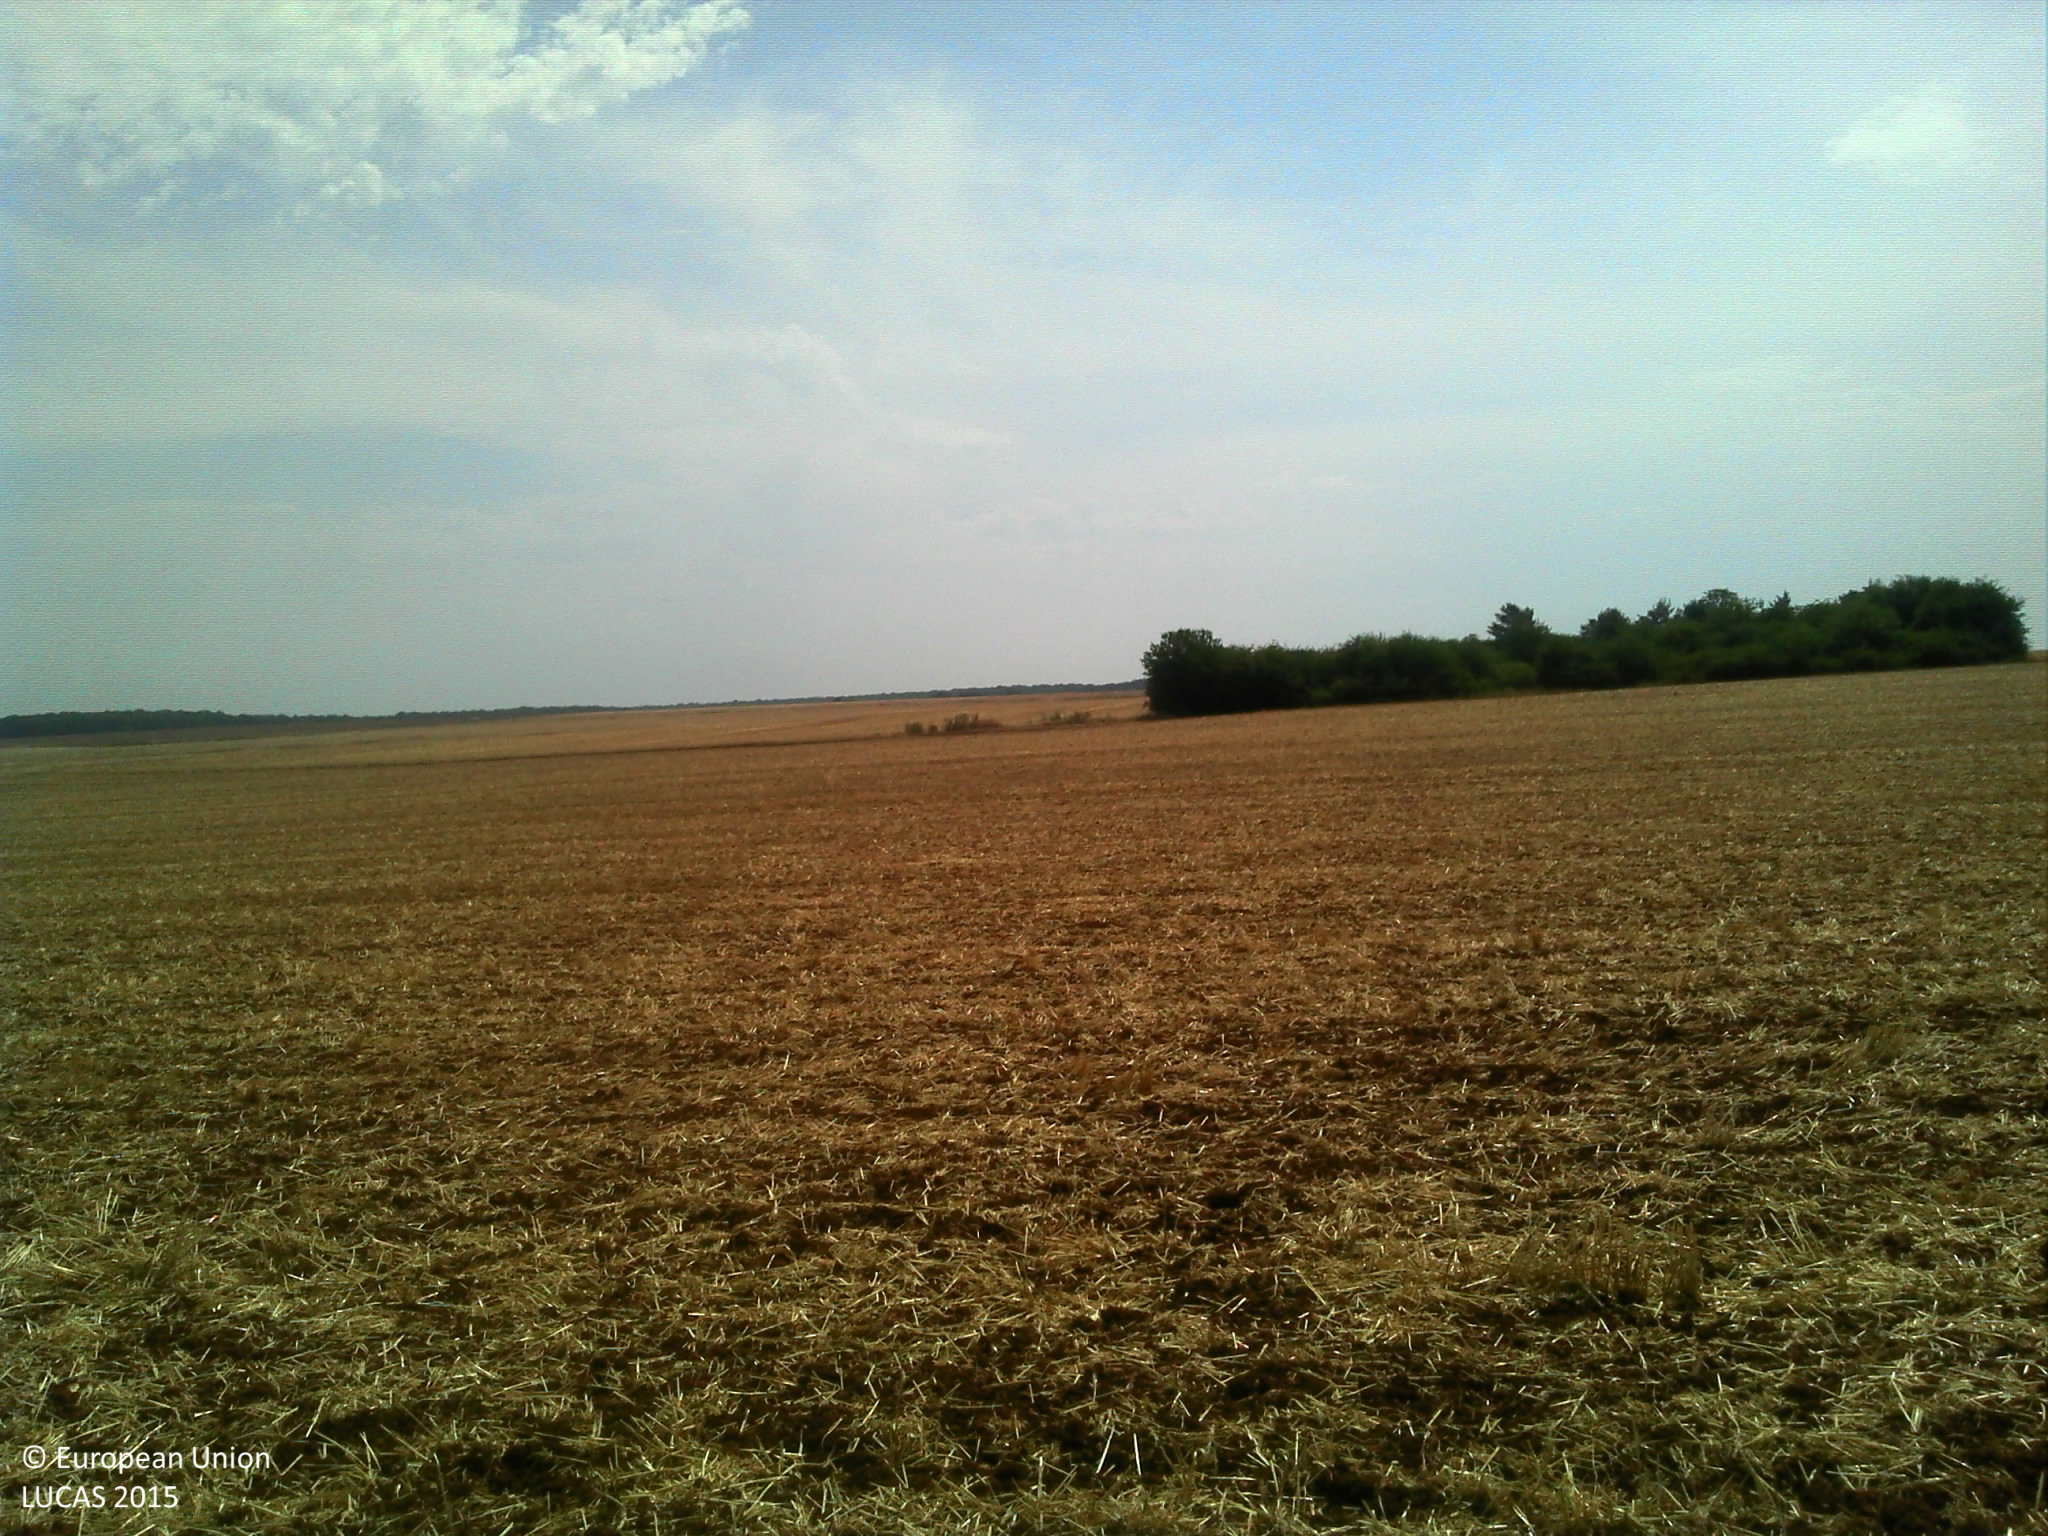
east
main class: Cropland
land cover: Common wheat
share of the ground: 10 - 25 %
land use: Agriculture (excluding fallow land and kitchen gardens)
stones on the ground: 10 - 25 %
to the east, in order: Common wheat; Grass margins; Tracks; Grass margins; Common wheat
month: September
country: FR
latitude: 47.9599
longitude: 4.8697
